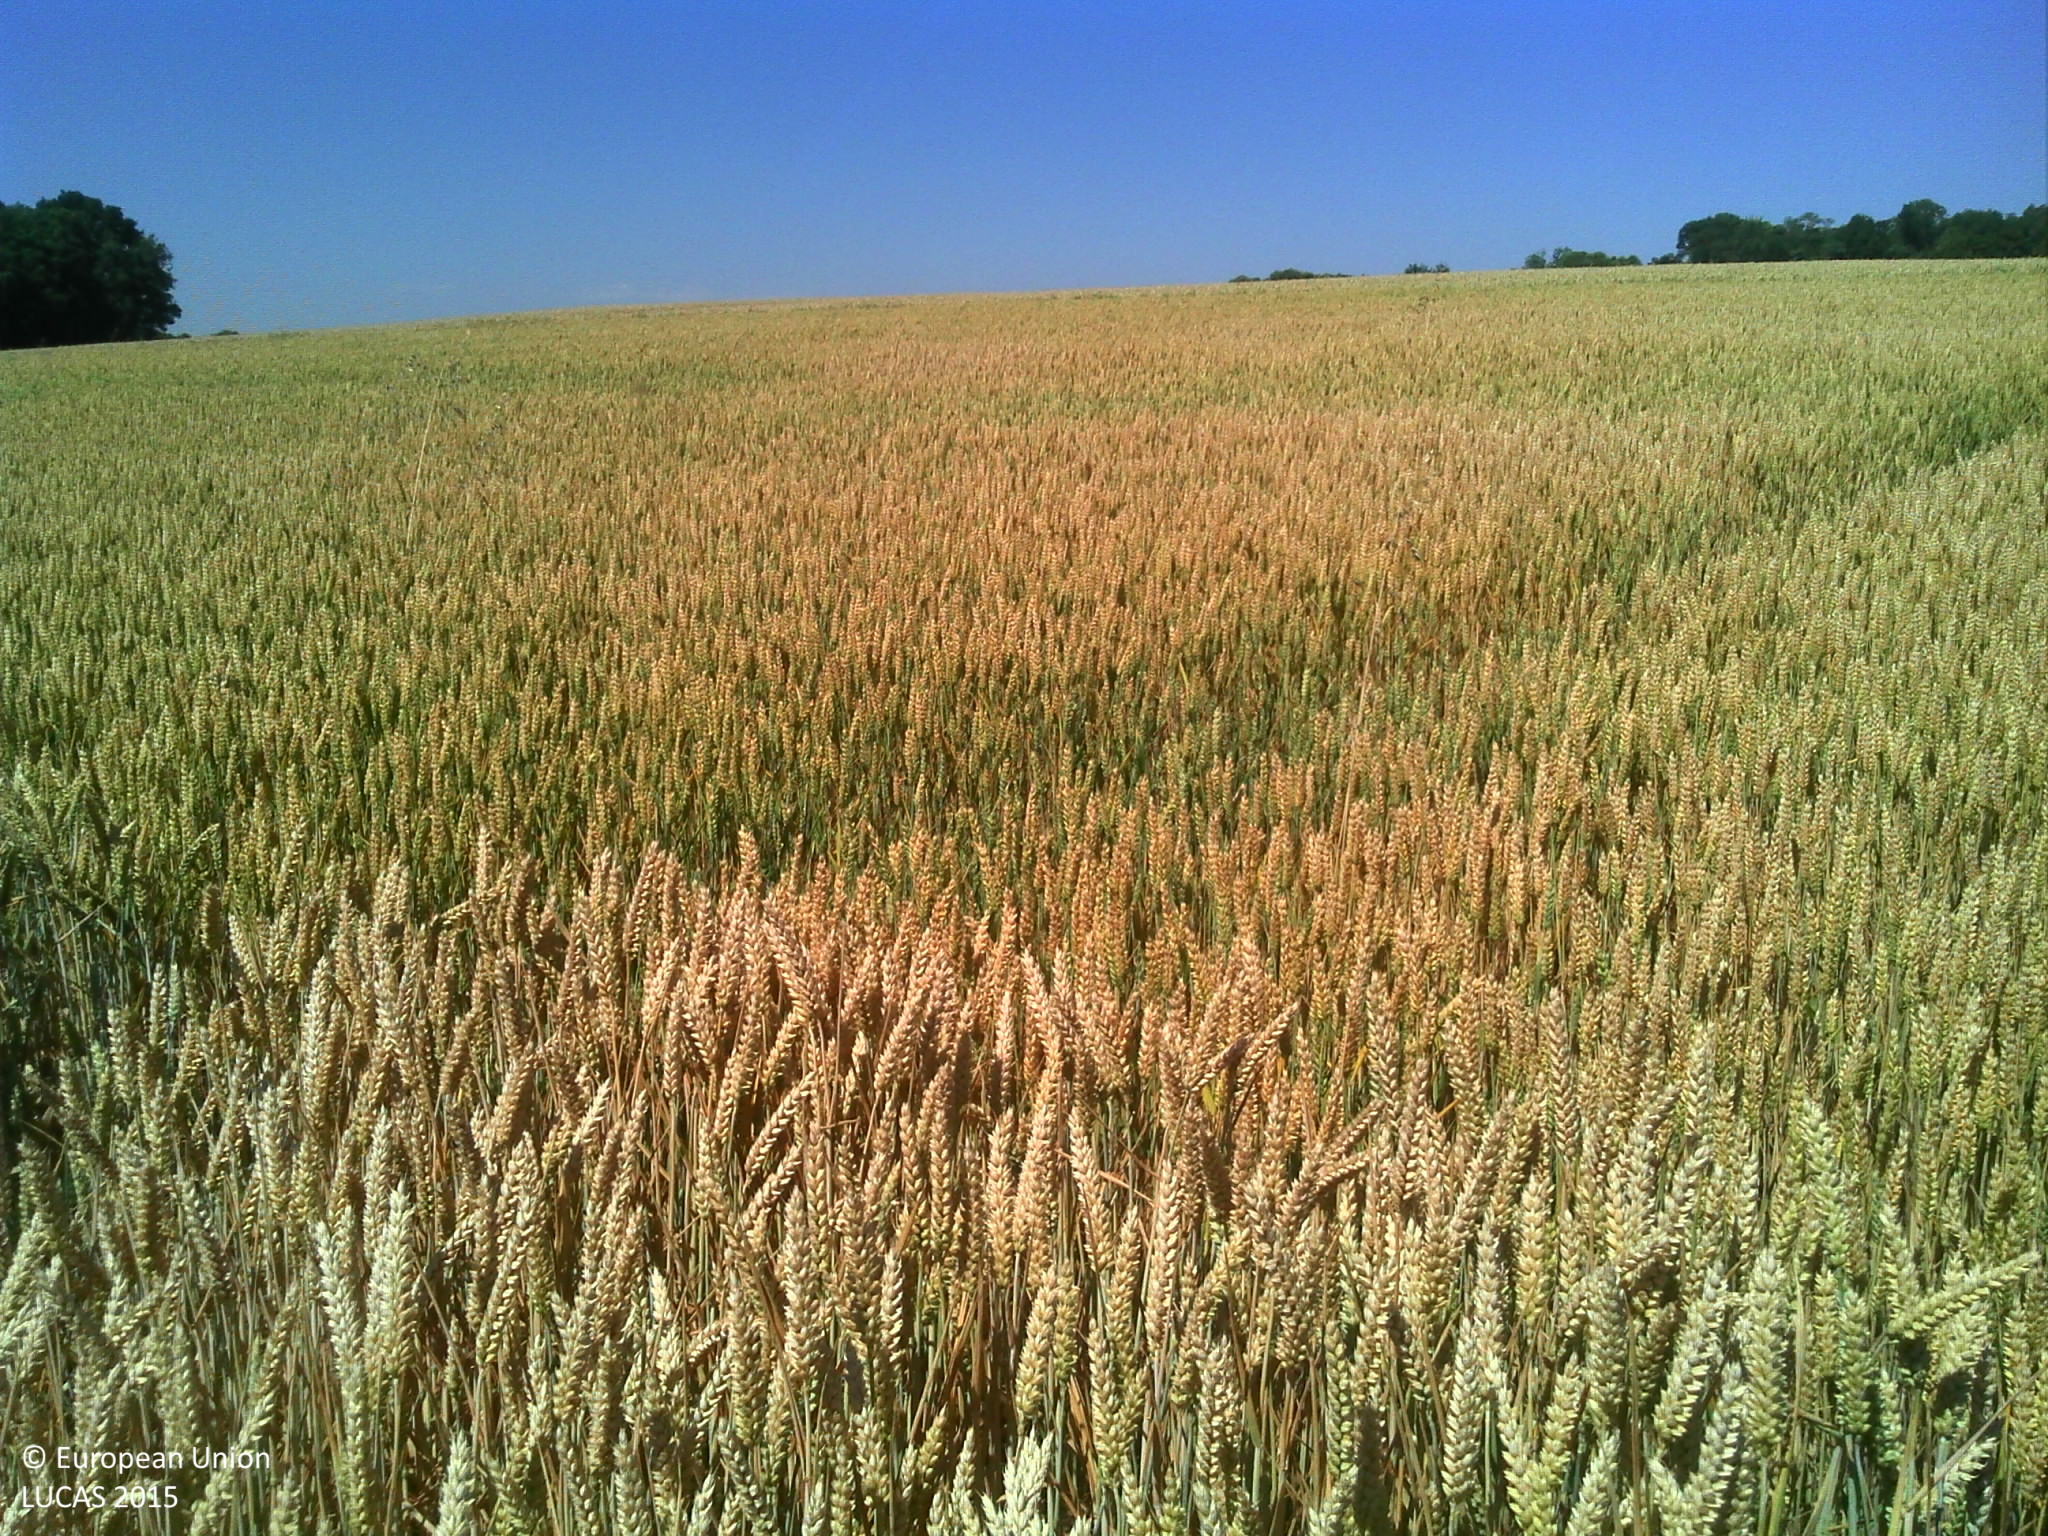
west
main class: Cropland
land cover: Common wheat
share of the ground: > 75 %
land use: Agriculture (excluding fallow land and kitchen gardens)
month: July
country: FR
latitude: 48.9951
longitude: 3.3091
